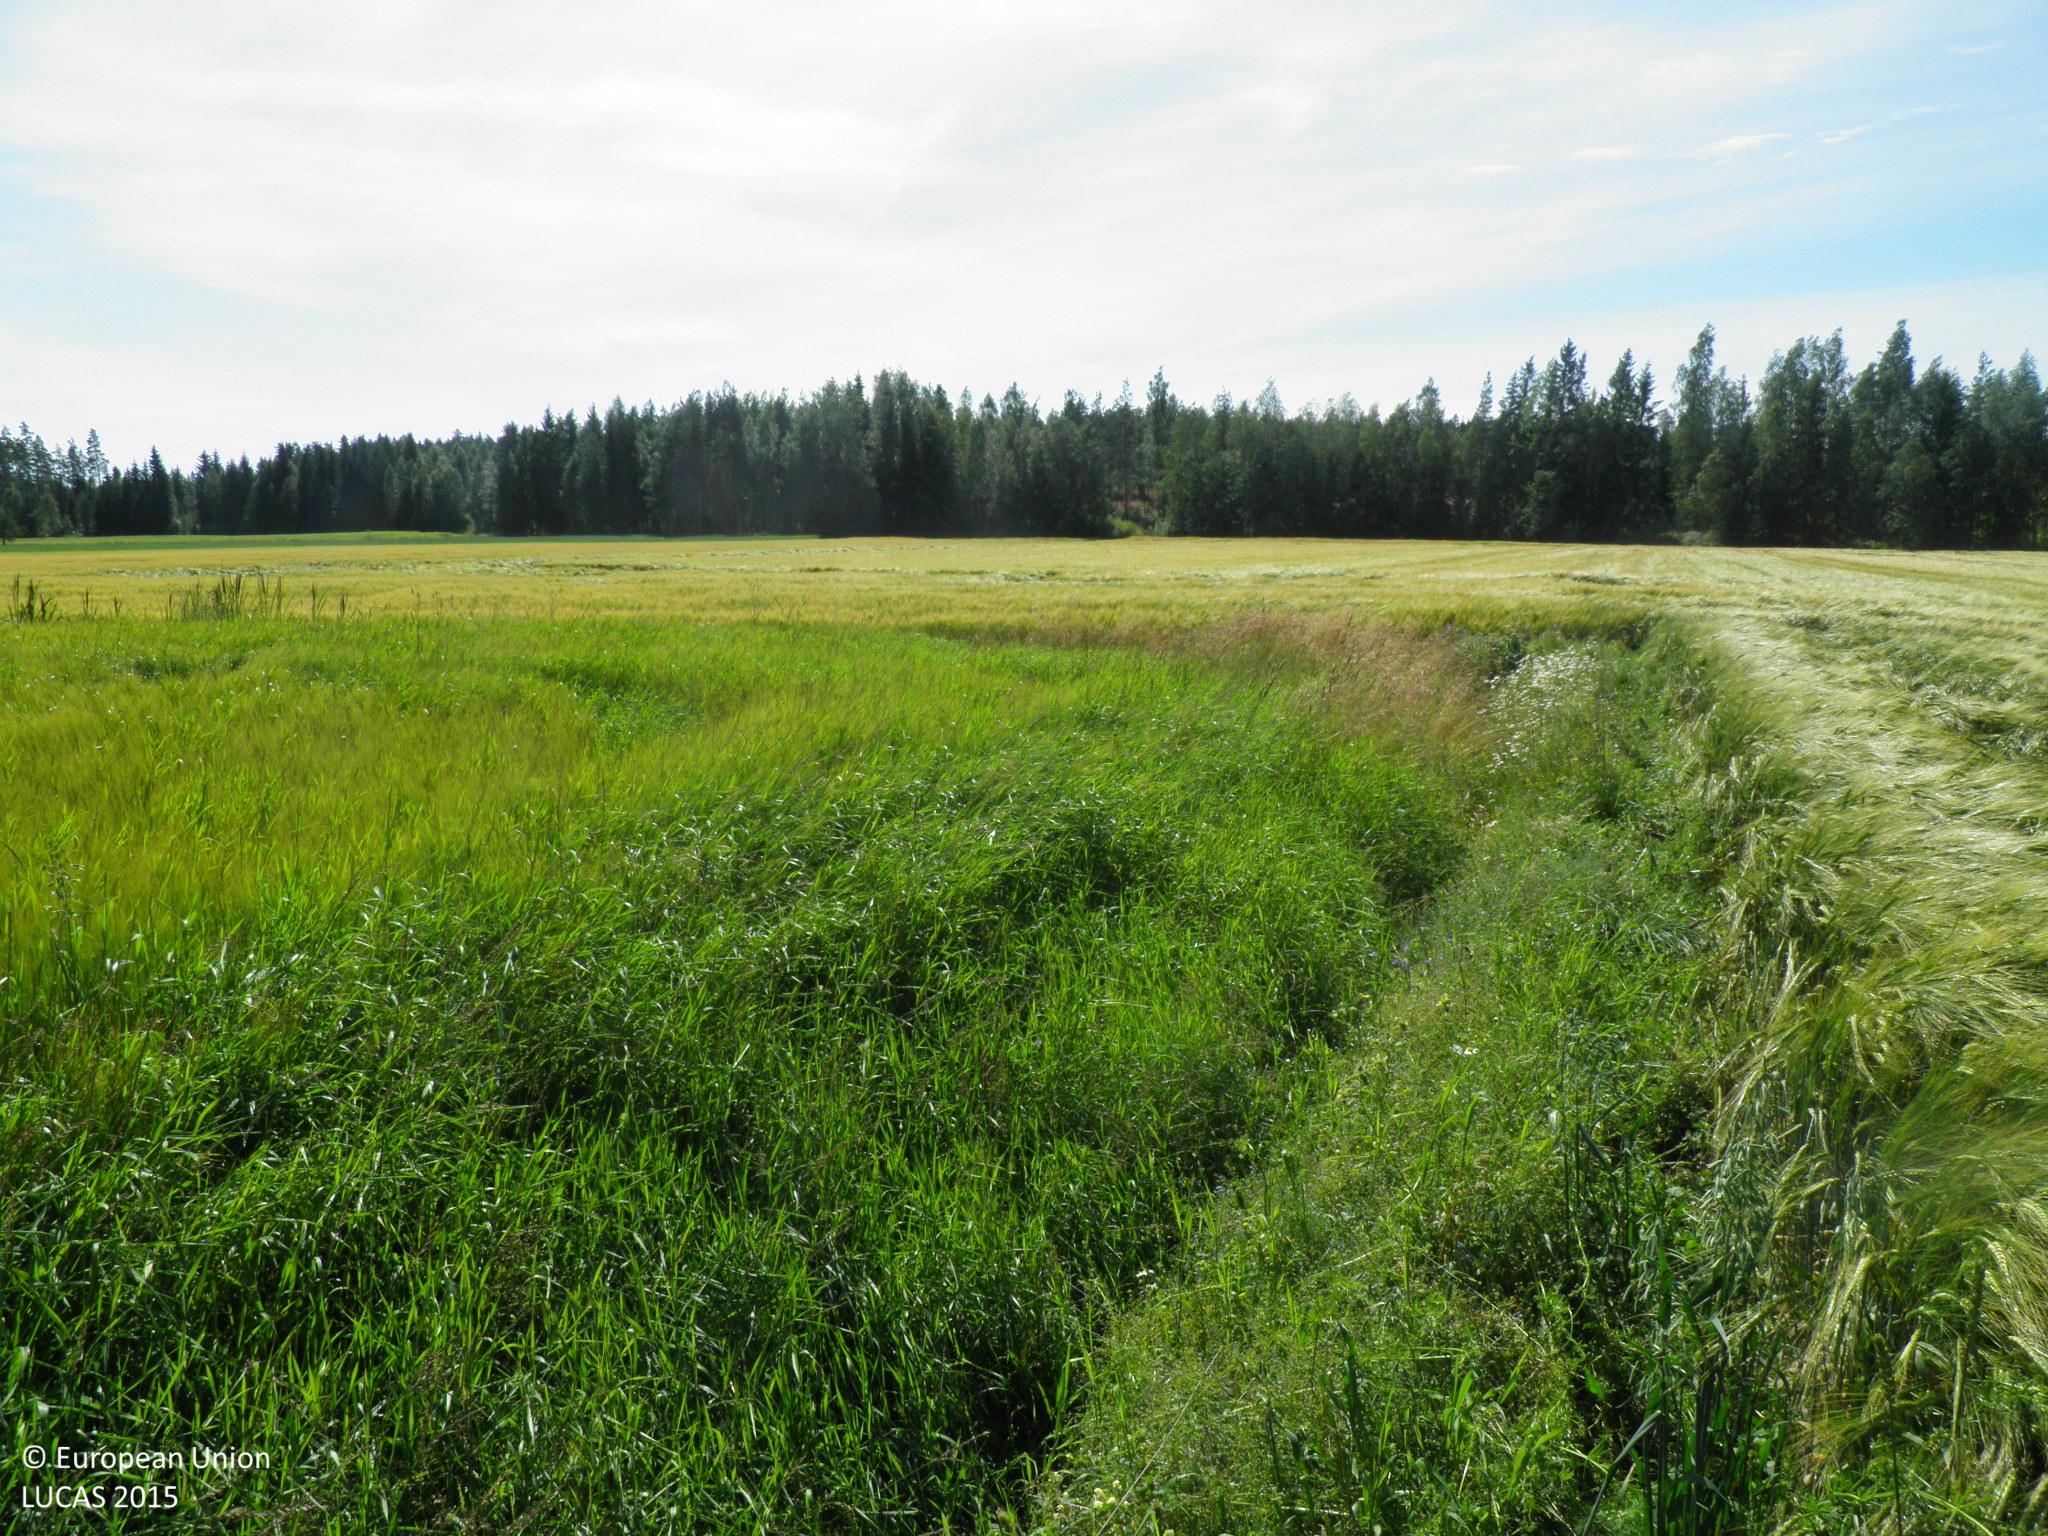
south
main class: Cropland
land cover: Barley
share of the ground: > 75 %
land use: Agriculture (excluding fallow land and kitchen gardens)
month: August
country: FI
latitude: 61.0185
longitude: 22.8193
